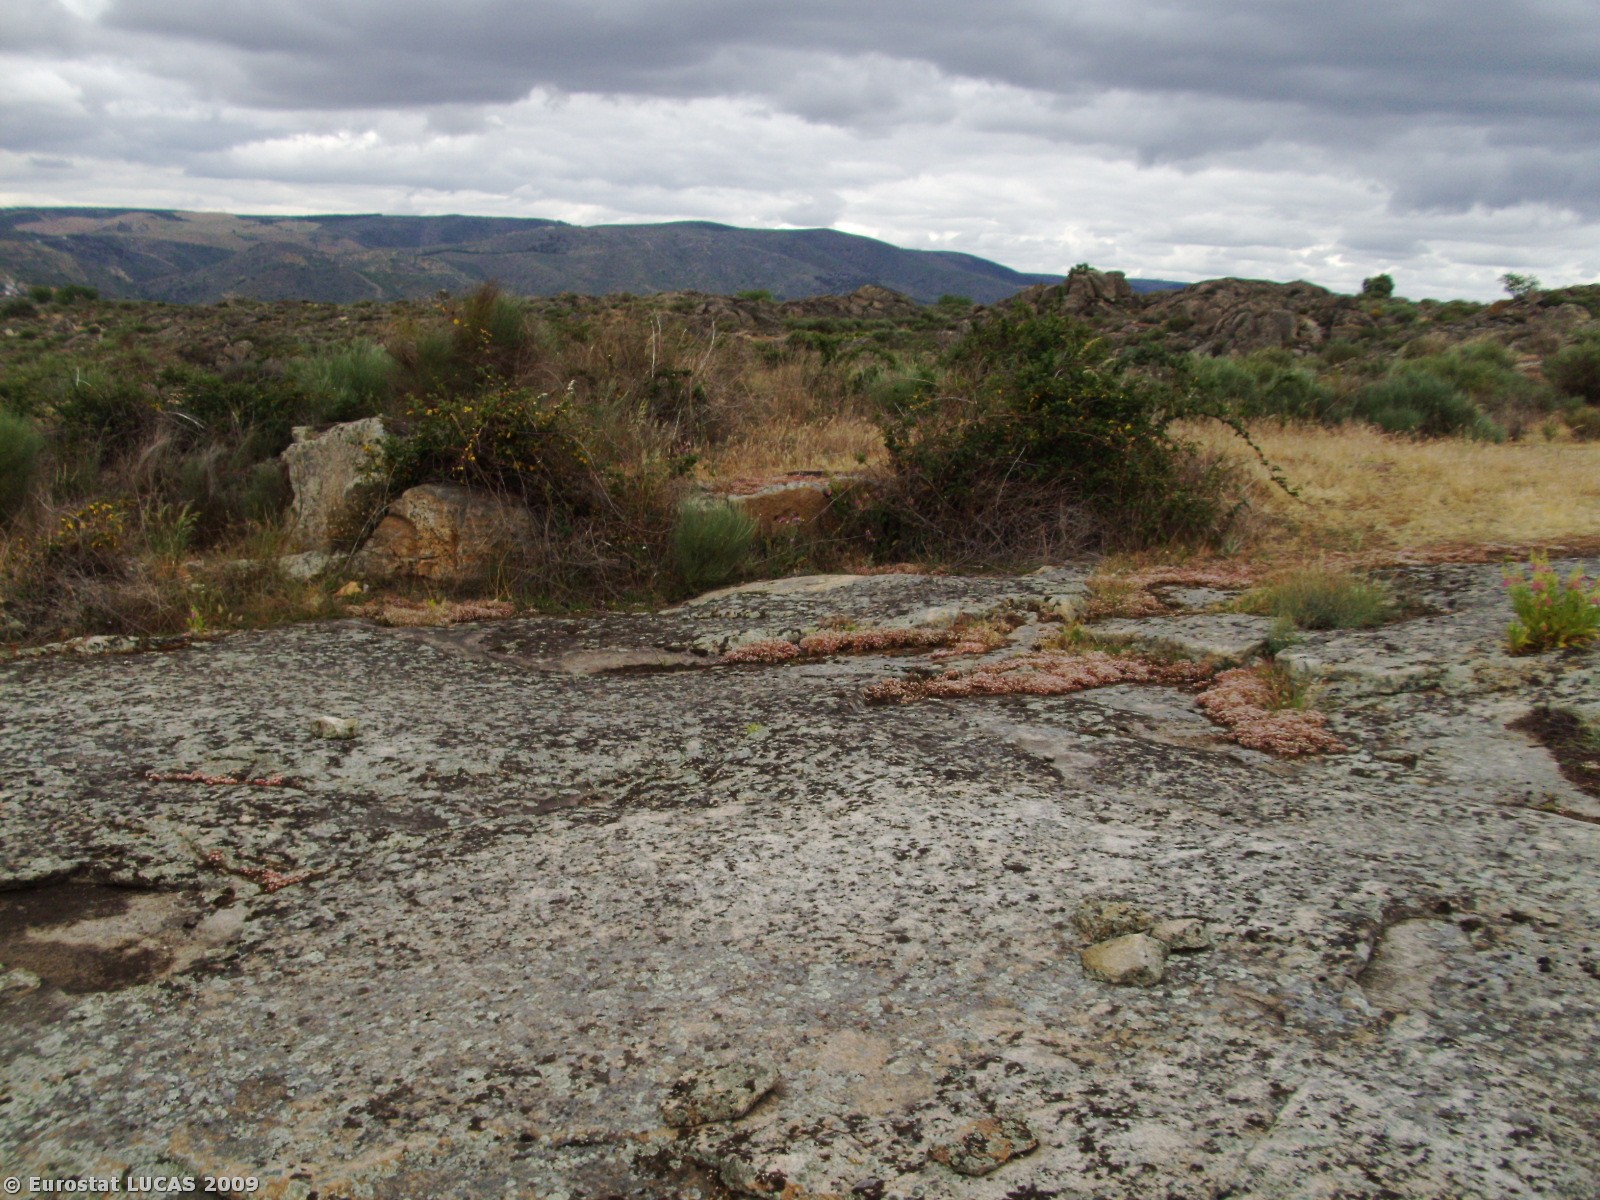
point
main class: Shrubland
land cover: Shrubland without tree cover
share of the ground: 25 - 50 %
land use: Unused
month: May
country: PT
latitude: 40.9909
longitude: -7.1684
